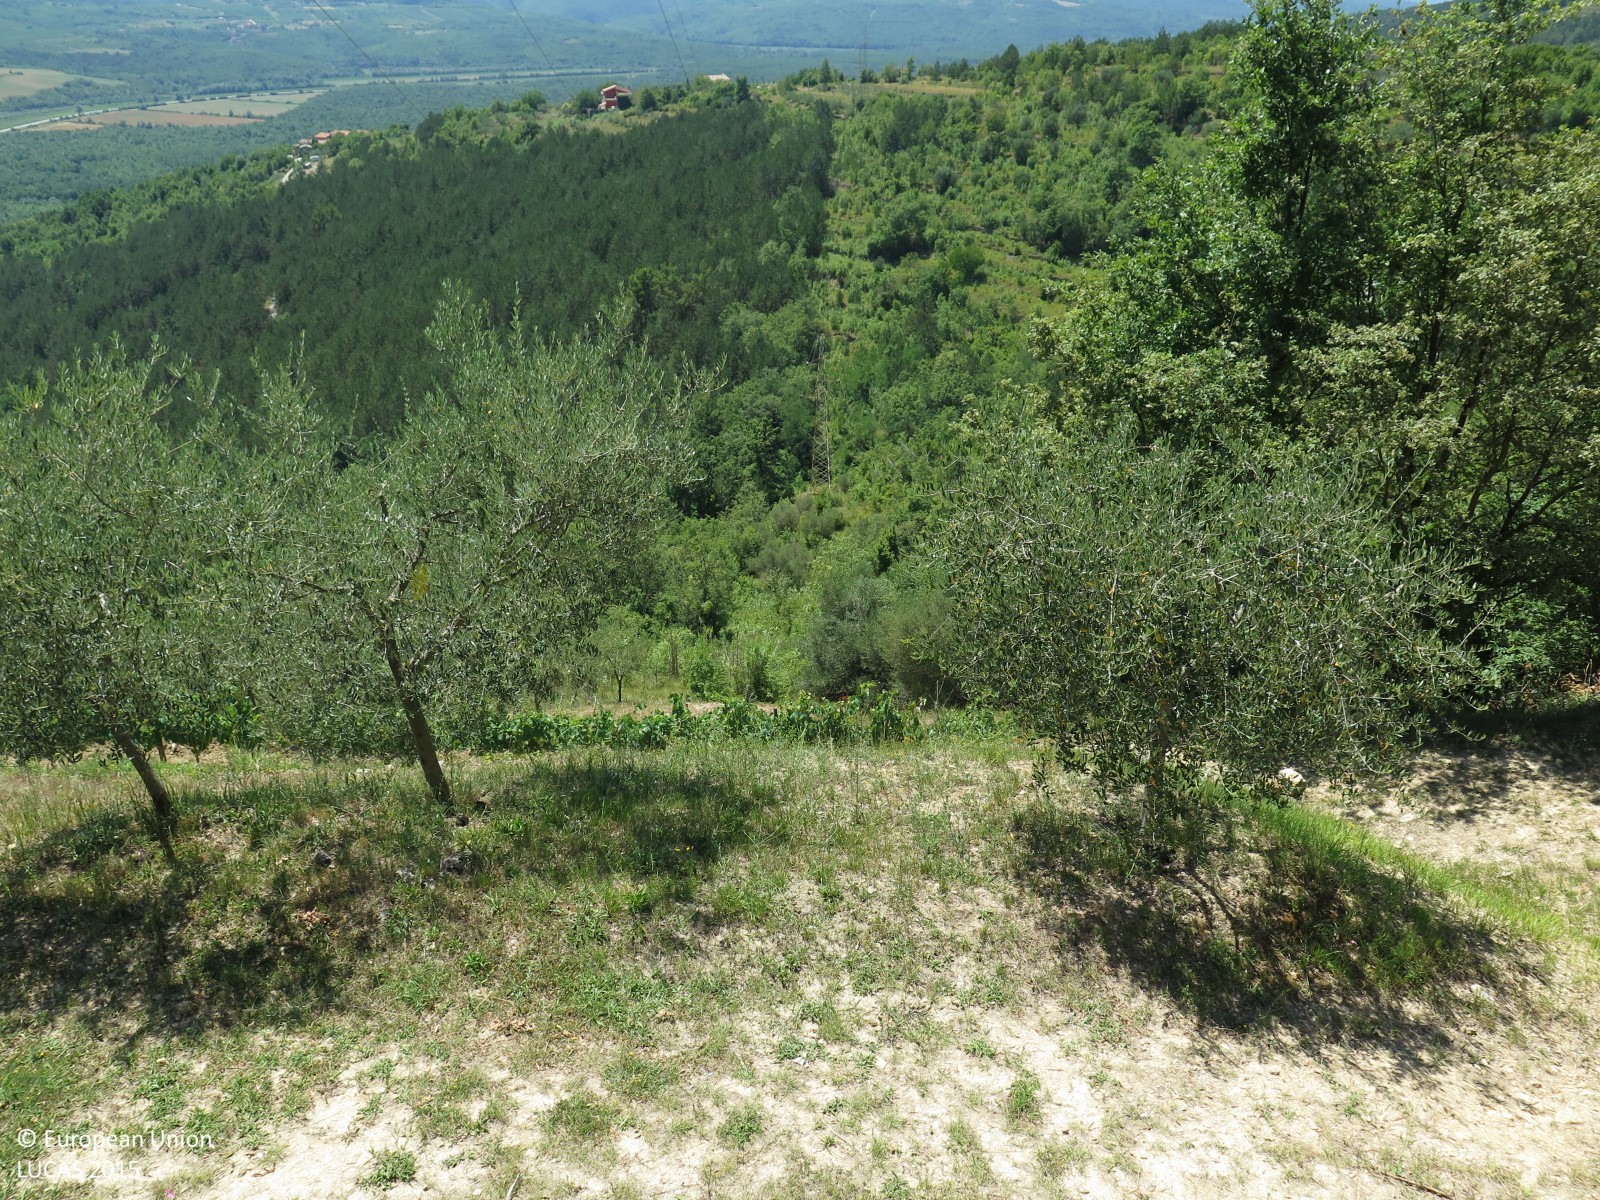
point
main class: Woodland
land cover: Pine dominated mixed woodland
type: coniferous forest of the mediterranean region
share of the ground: > 75 %
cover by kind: coniferous forest trees 75 %, broadleaved forest trees 25 %
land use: Semi-natural and natural areas not in use
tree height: > 5 m
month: July
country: HR
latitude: 45.3625
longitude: 13.8378
